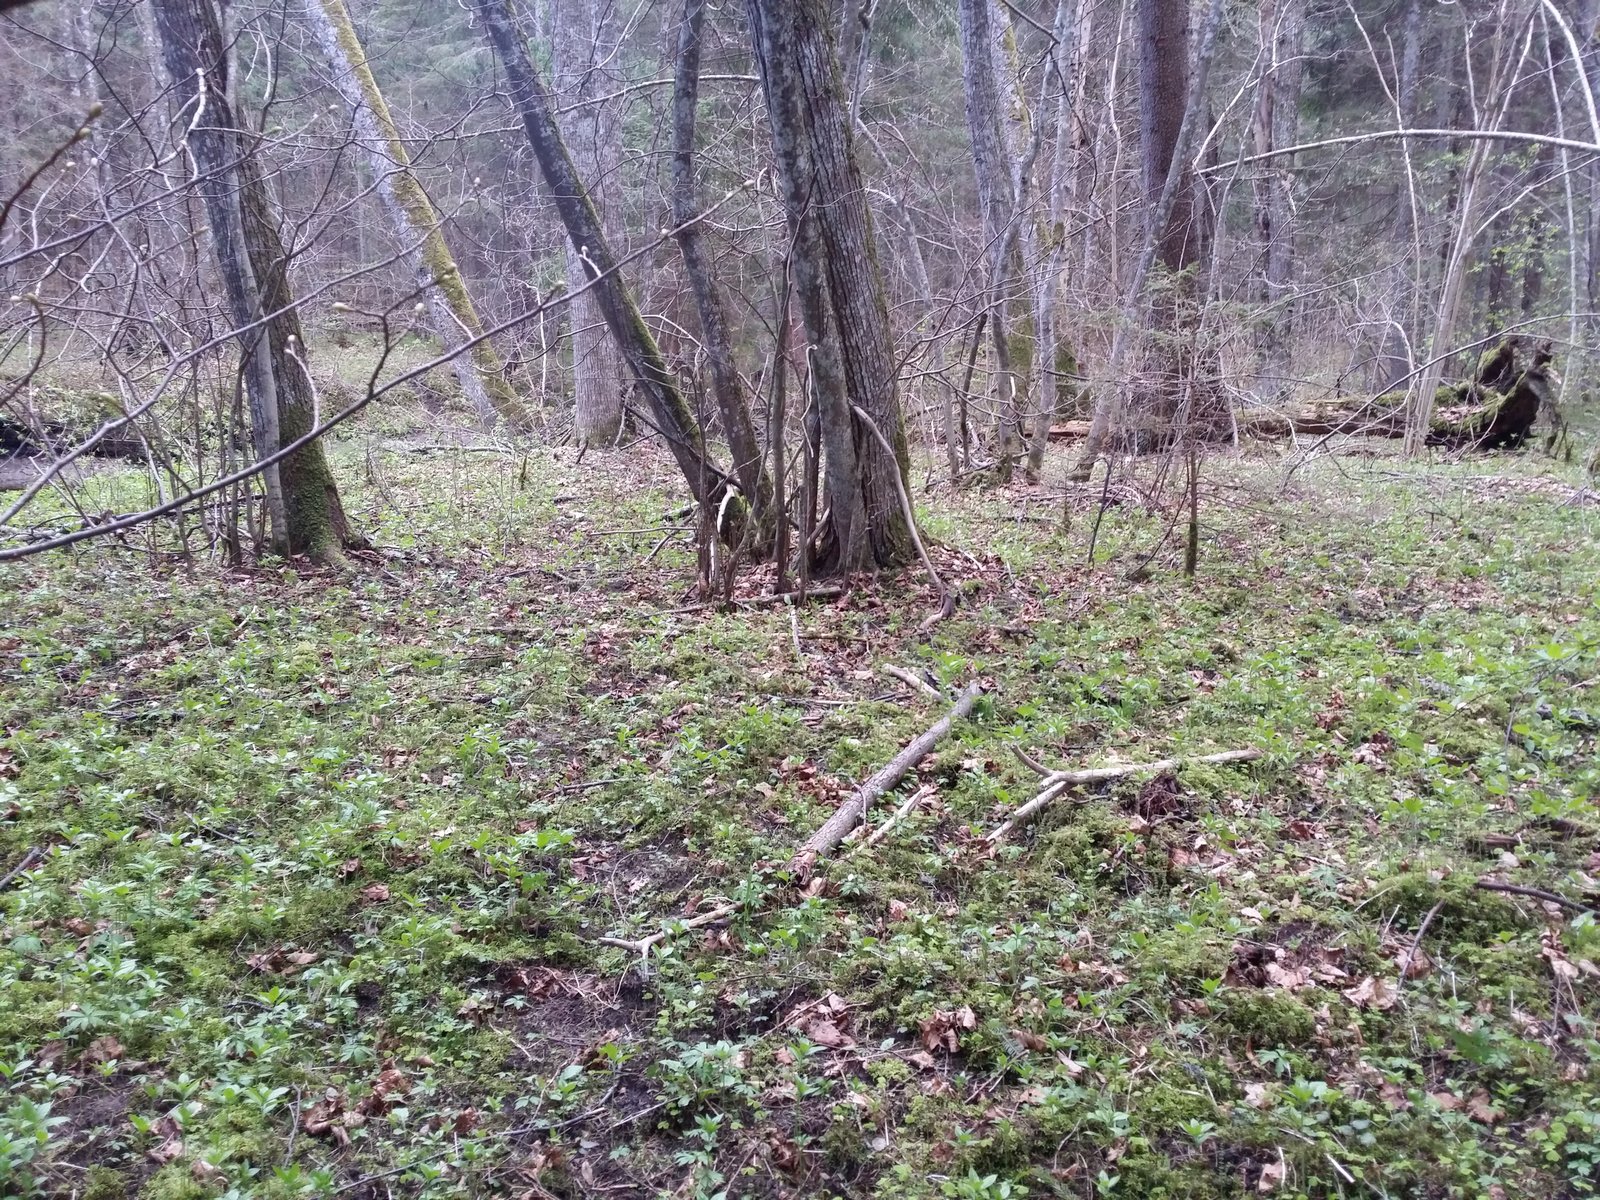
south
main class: Woodland
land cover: Spruce dominated mixed woodland
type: hemiboreal forest and nemoral coniferous forest and mixed broadleaved-coniferous forest
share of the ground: > 75 %
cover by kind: coniferous forest trees 65 %, broadleaved forest trees 25 %, lichens and mosses 10 %
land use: Forestry
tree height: > 5 m
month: May
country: LV
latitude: 57.3785
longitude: 26.0129
